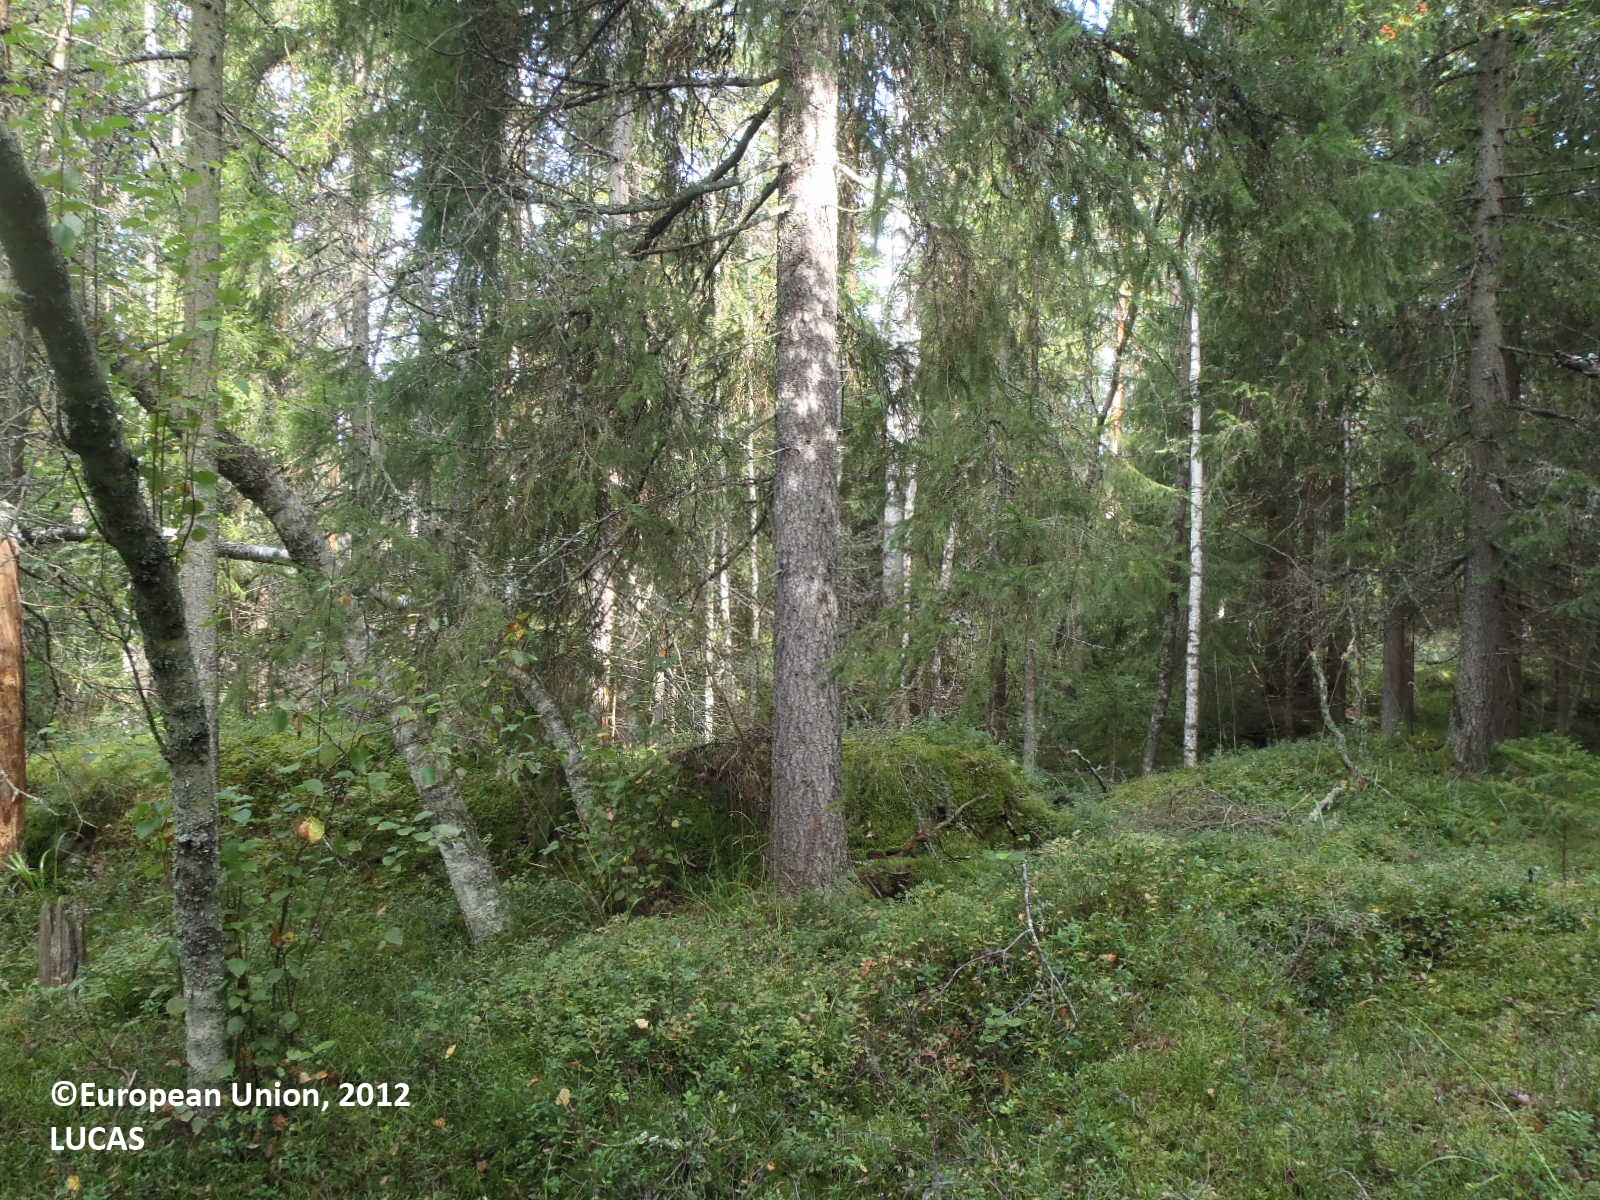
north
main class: Woodland
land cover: Spruce dominated coniferous woodland
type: boreal forest
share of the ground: 50 - 75 %
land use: Forestry
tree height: > 5 m
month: August
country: FI
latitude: 60.8093
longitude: 22.2884
